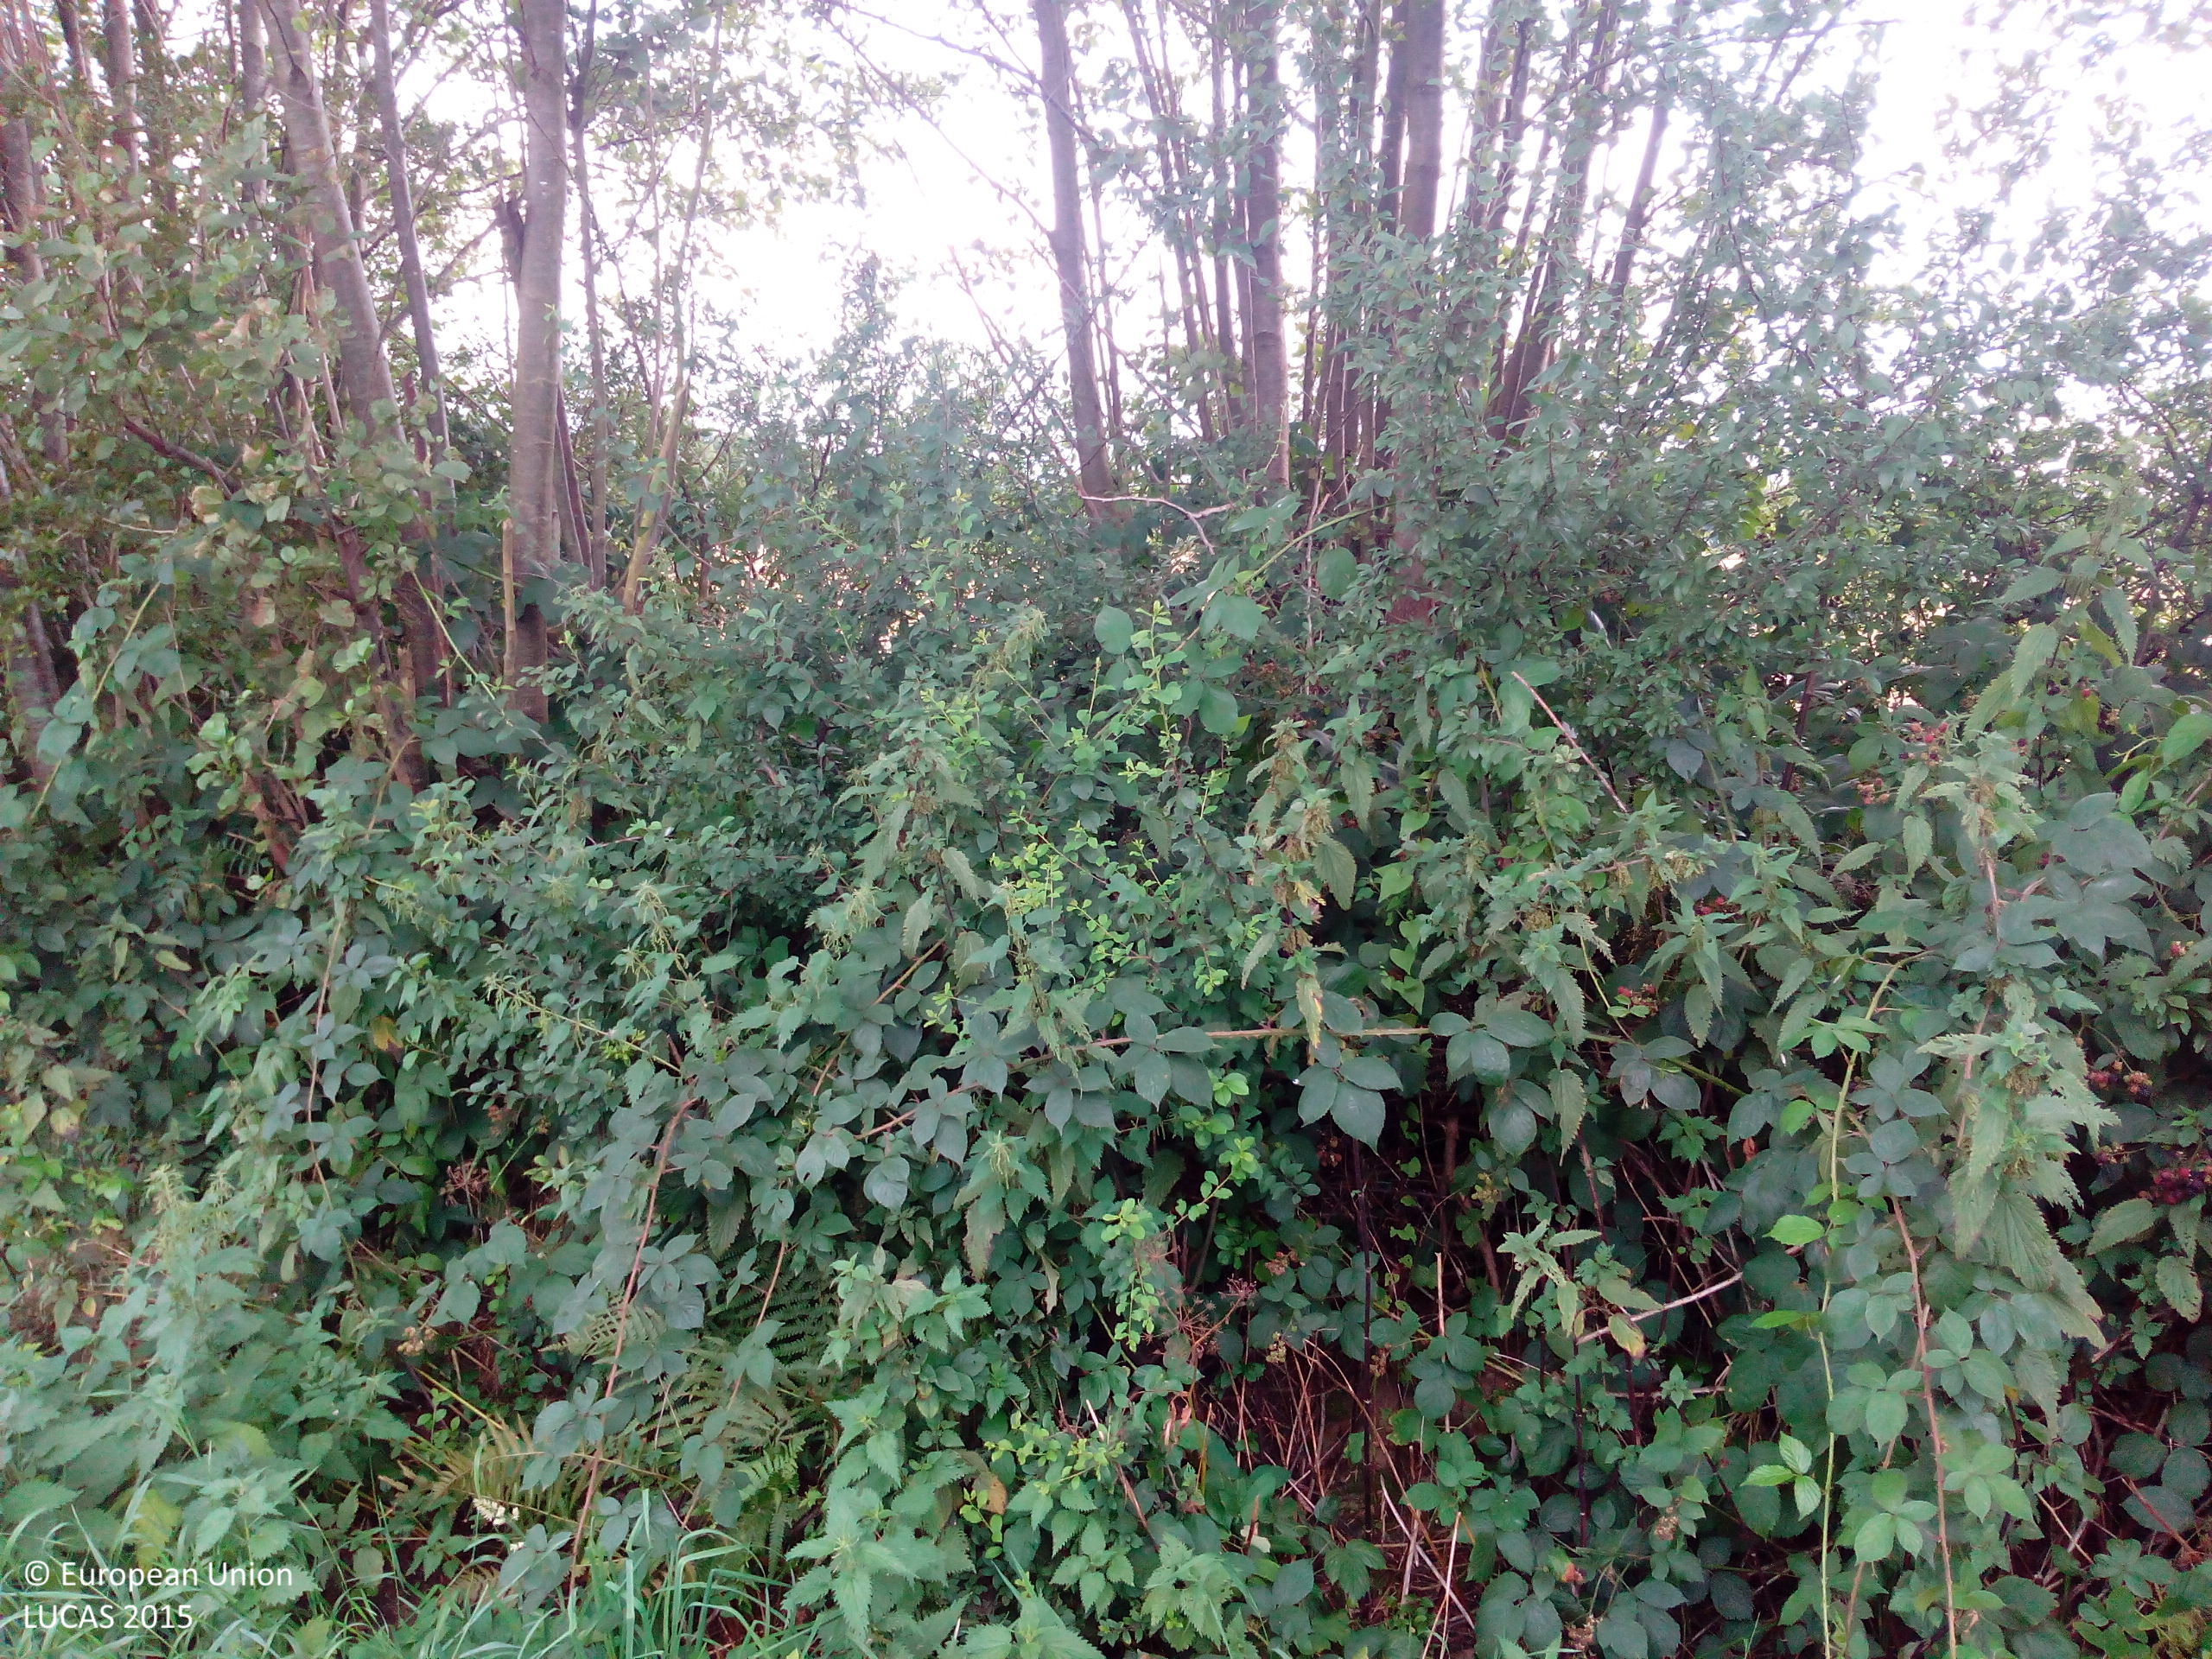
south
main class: Woodland
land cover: Broadleaved woodland
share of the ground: > 75 %
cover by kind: broadleaved forest trees 100 %
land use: Road transport
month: August
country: DE
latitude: 53.7973
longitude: 9.9545
